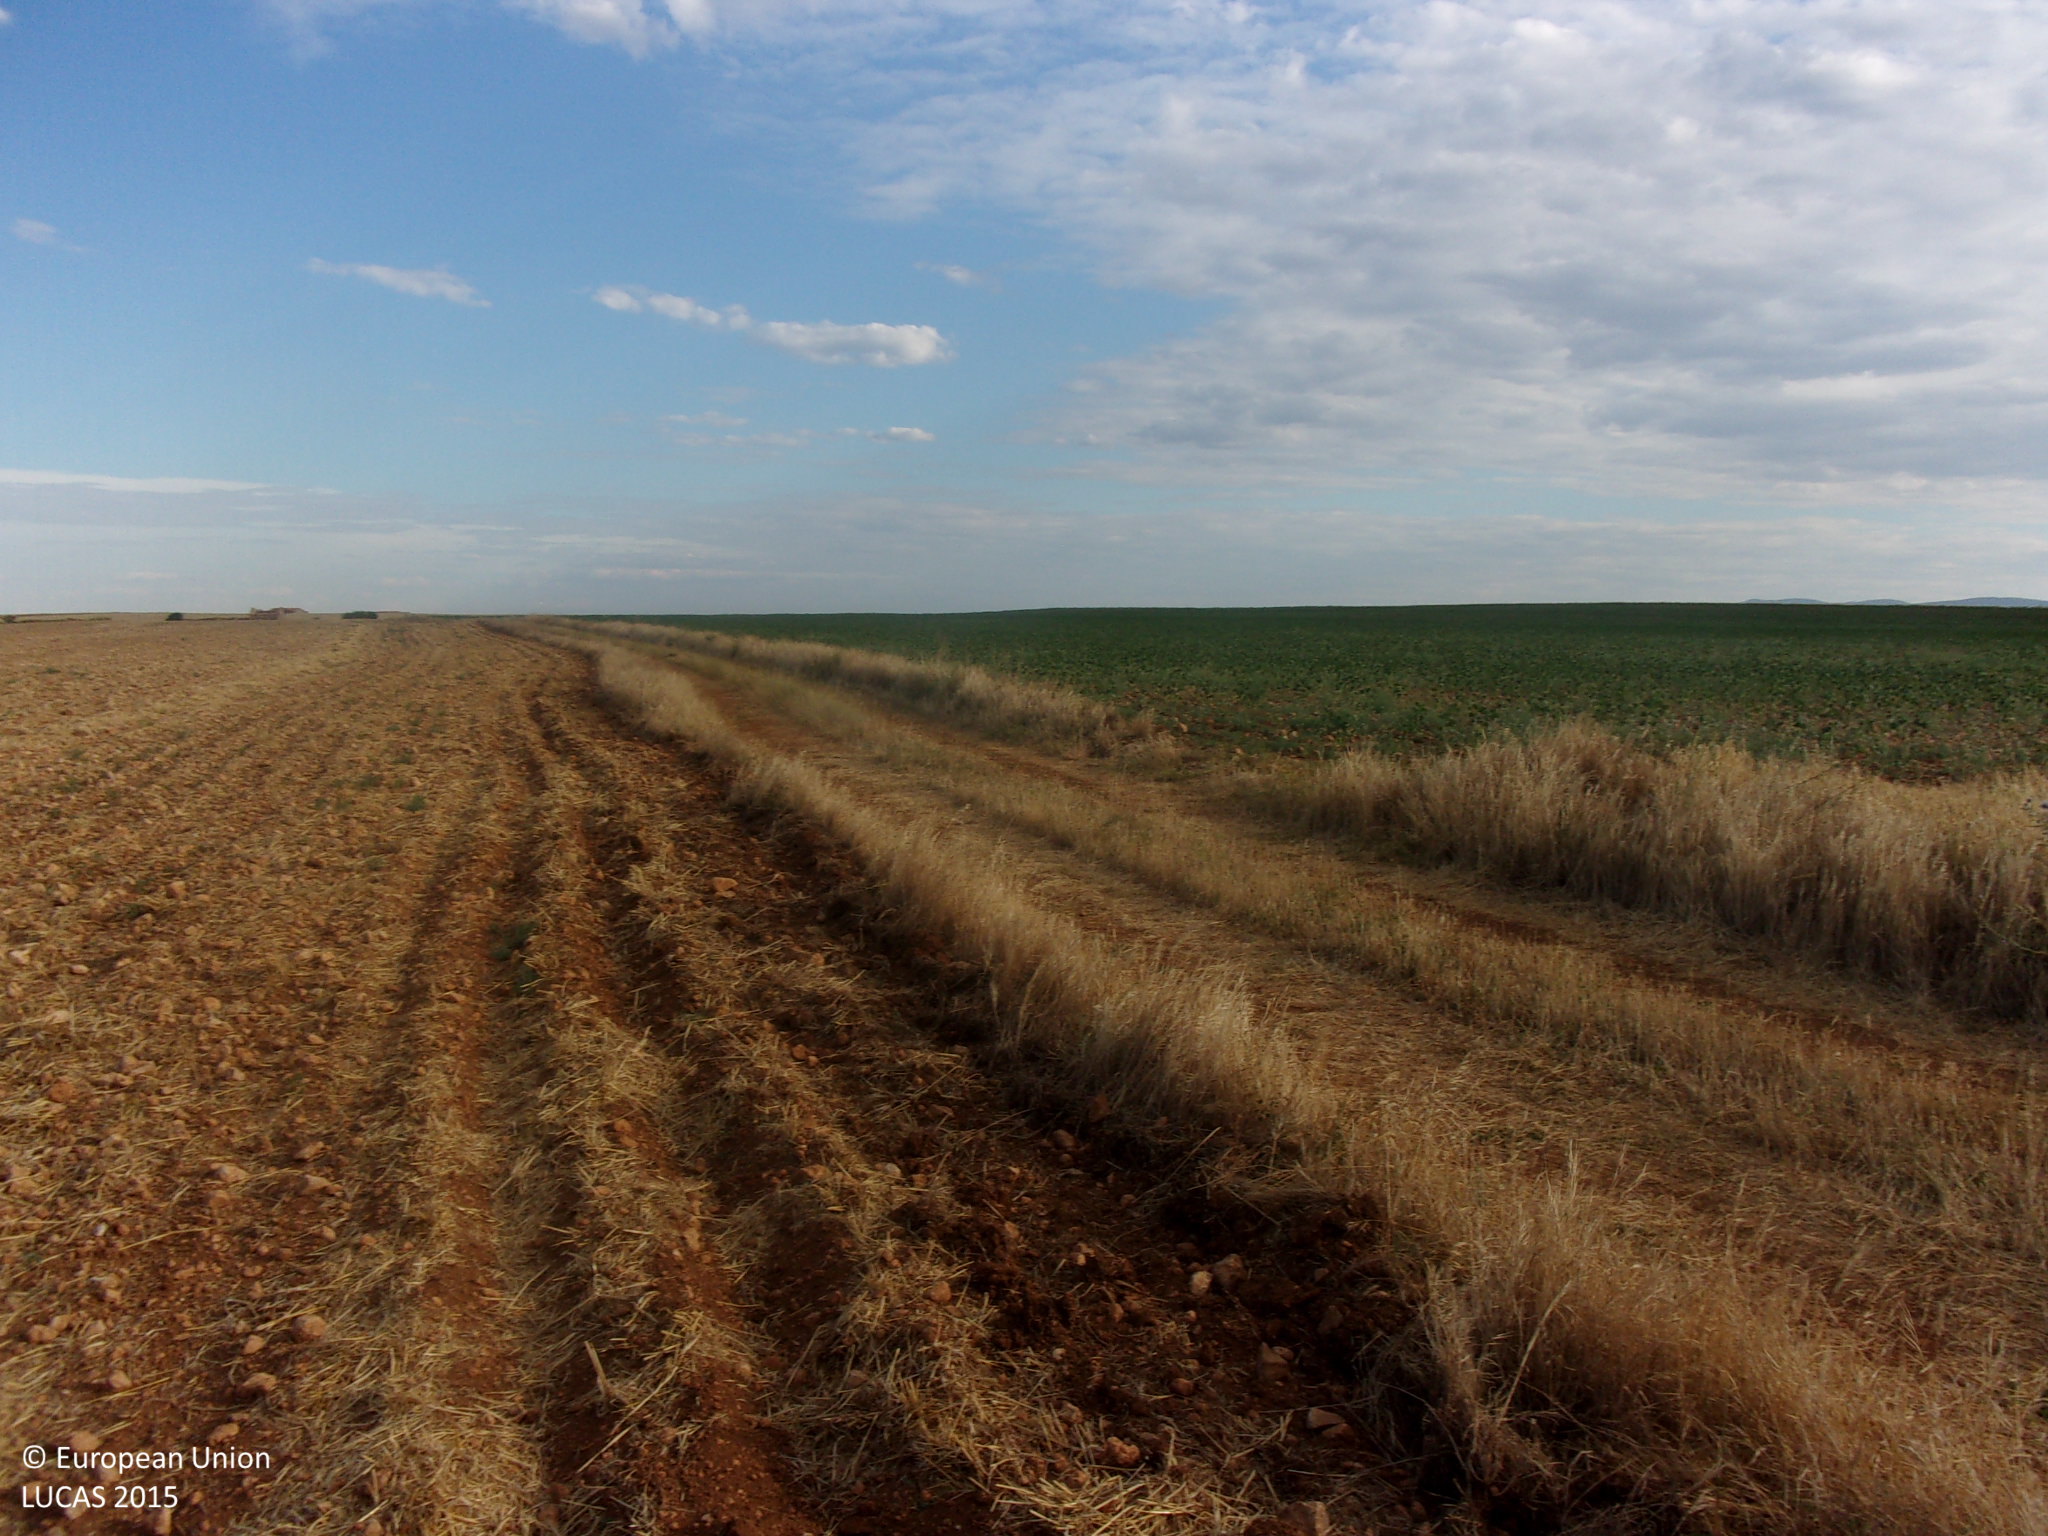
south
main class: Cropland
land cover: Barley
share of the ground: < 10 %
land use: Agriculture (excluding fallow land and kitchen gardens)
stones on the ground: < 10 %
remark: Harvested field
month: July
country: ES
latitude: 41.1720
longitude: -1.3805
